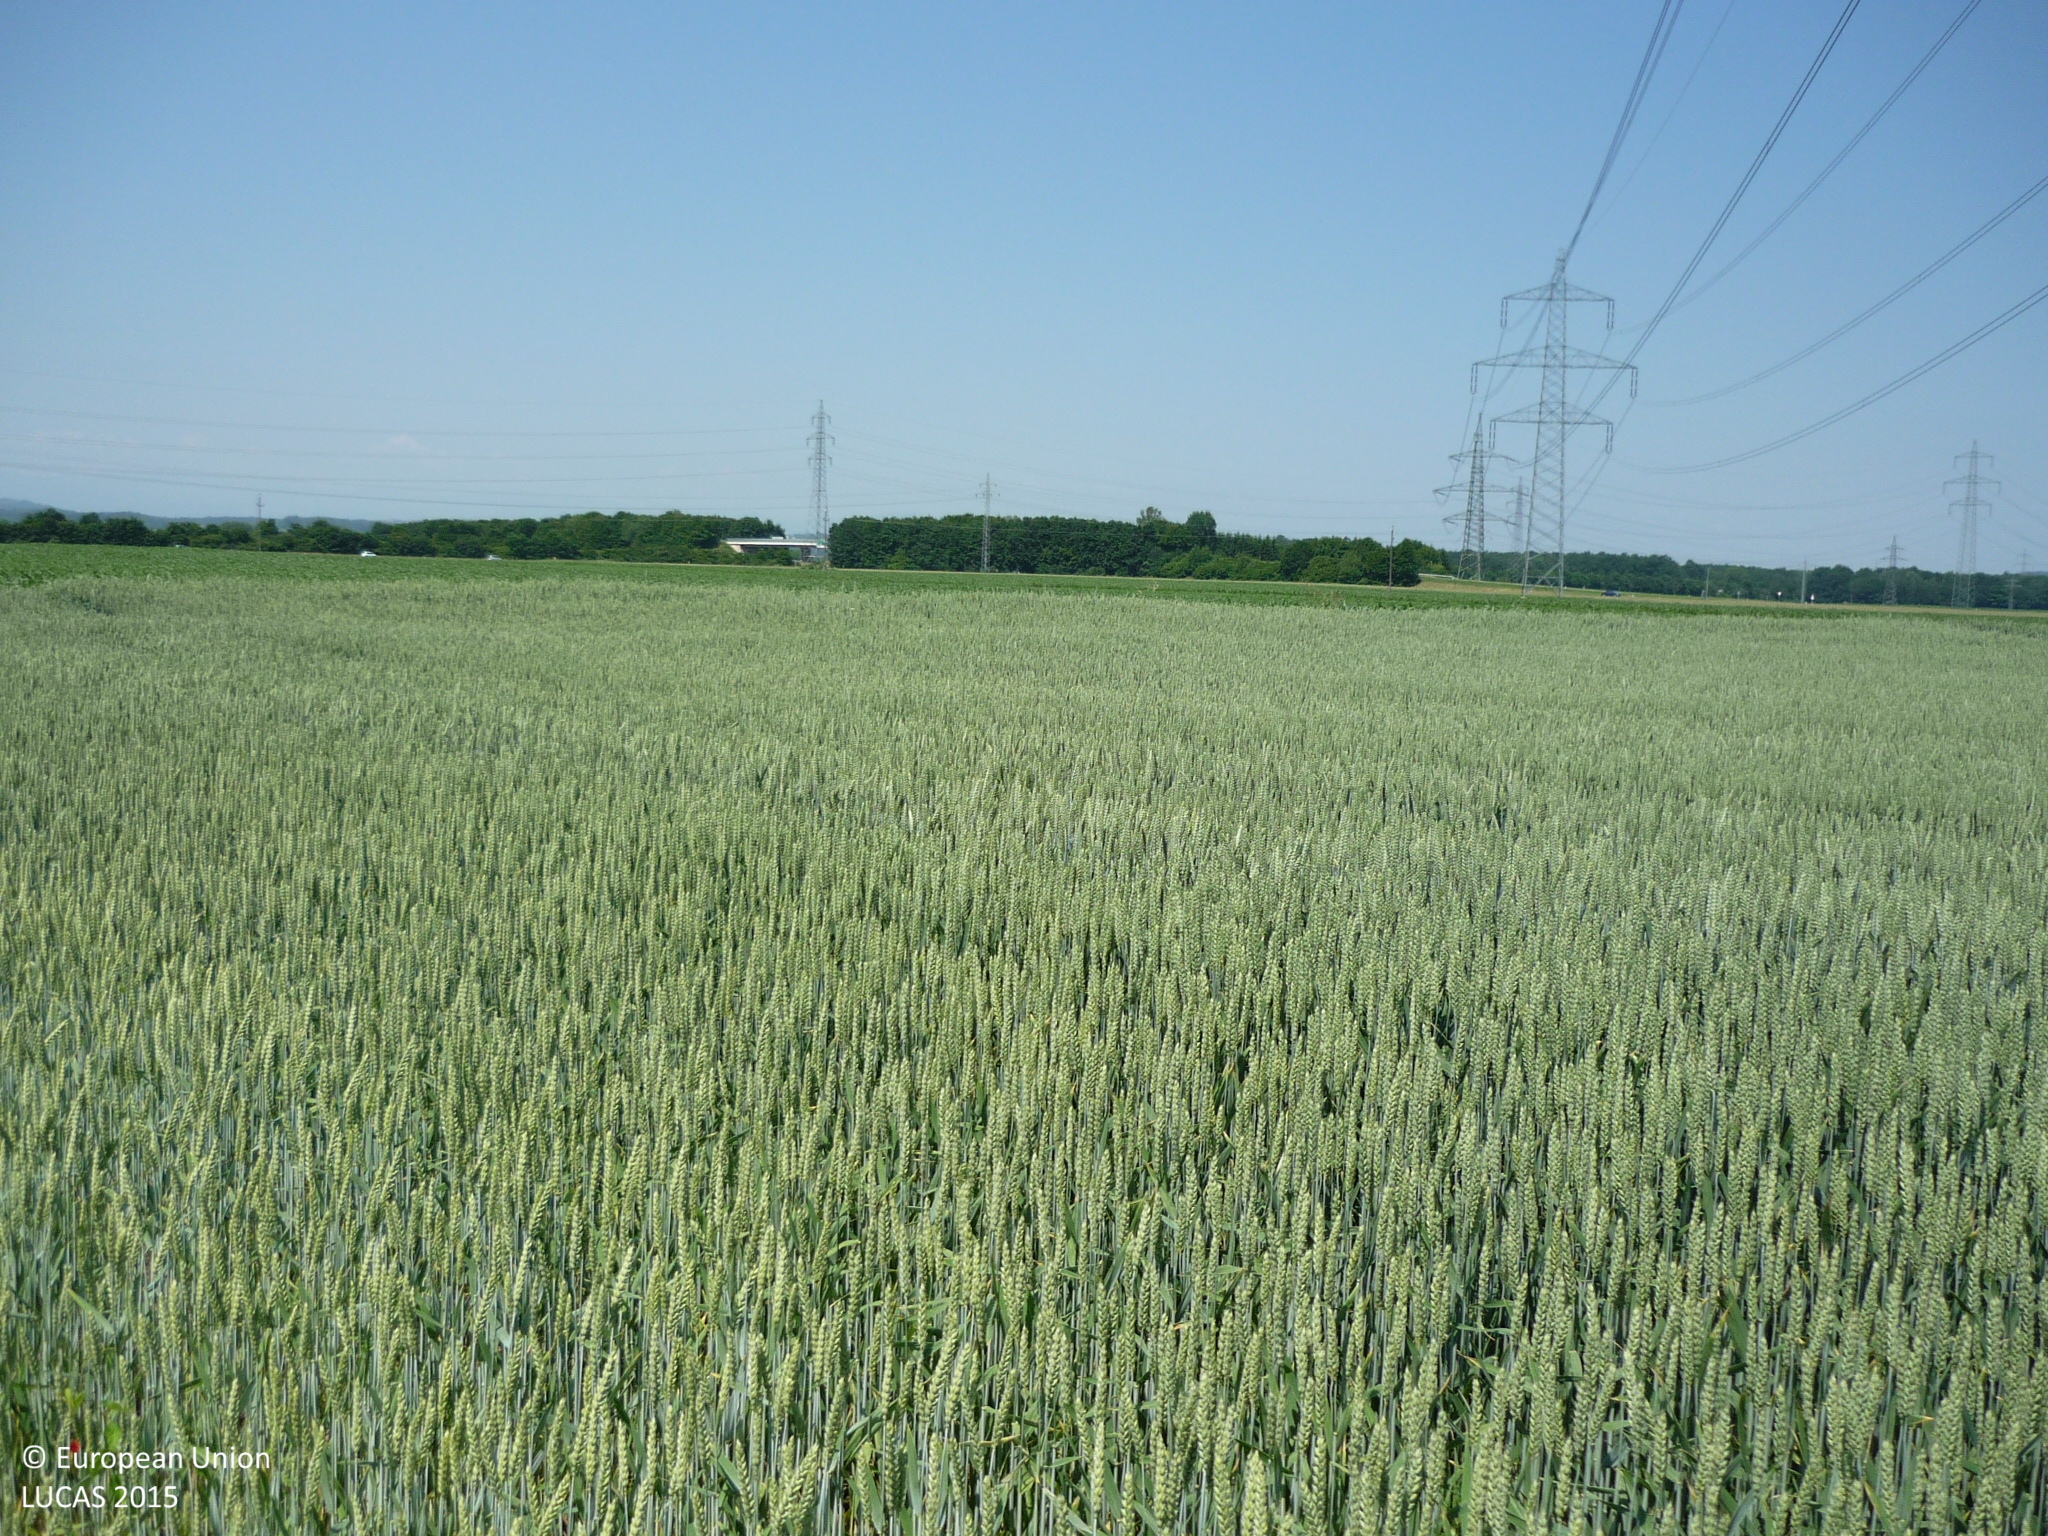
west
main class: Cropland
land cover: Maize
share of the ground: > 75 %
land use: Agriculture (excluding fallow land and kitchen gardens)
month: June
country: AT
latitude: 46.8198
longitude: 15.5701
